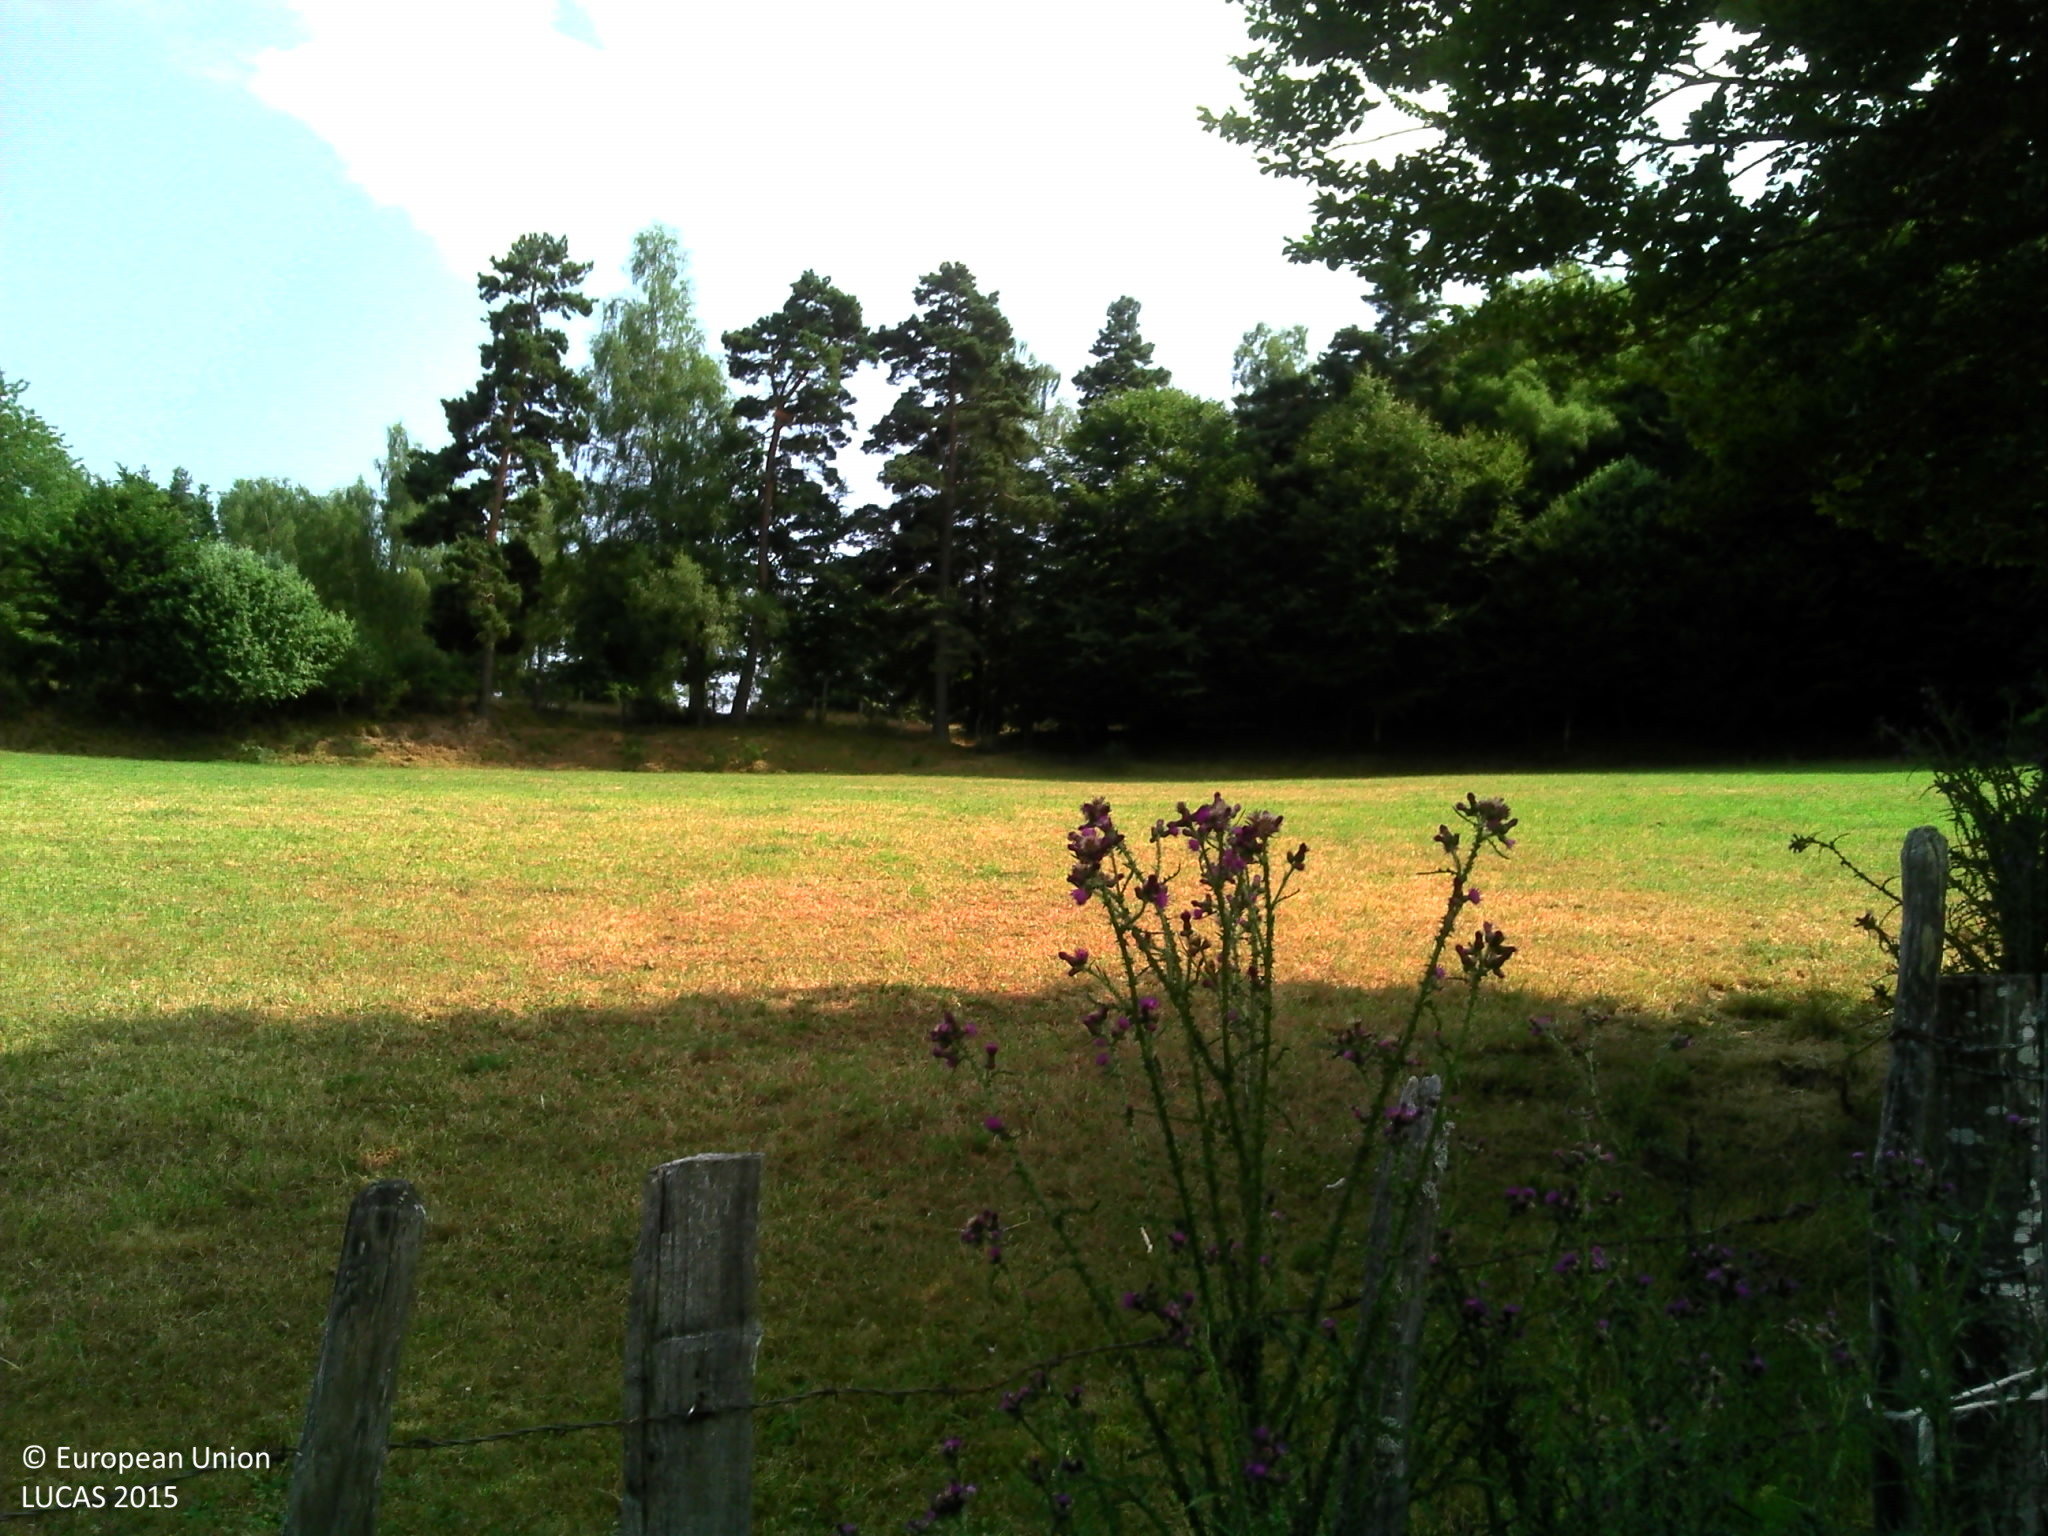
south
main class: Grassland
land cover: Grassland without tree/shrub cover
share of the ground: > 75 %
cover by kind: herbaceous plants 100 %
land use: Agriculture (excluding fallow land and kitchen gardens)
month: July
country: FR
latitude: 44.8875
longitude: 3.2041
